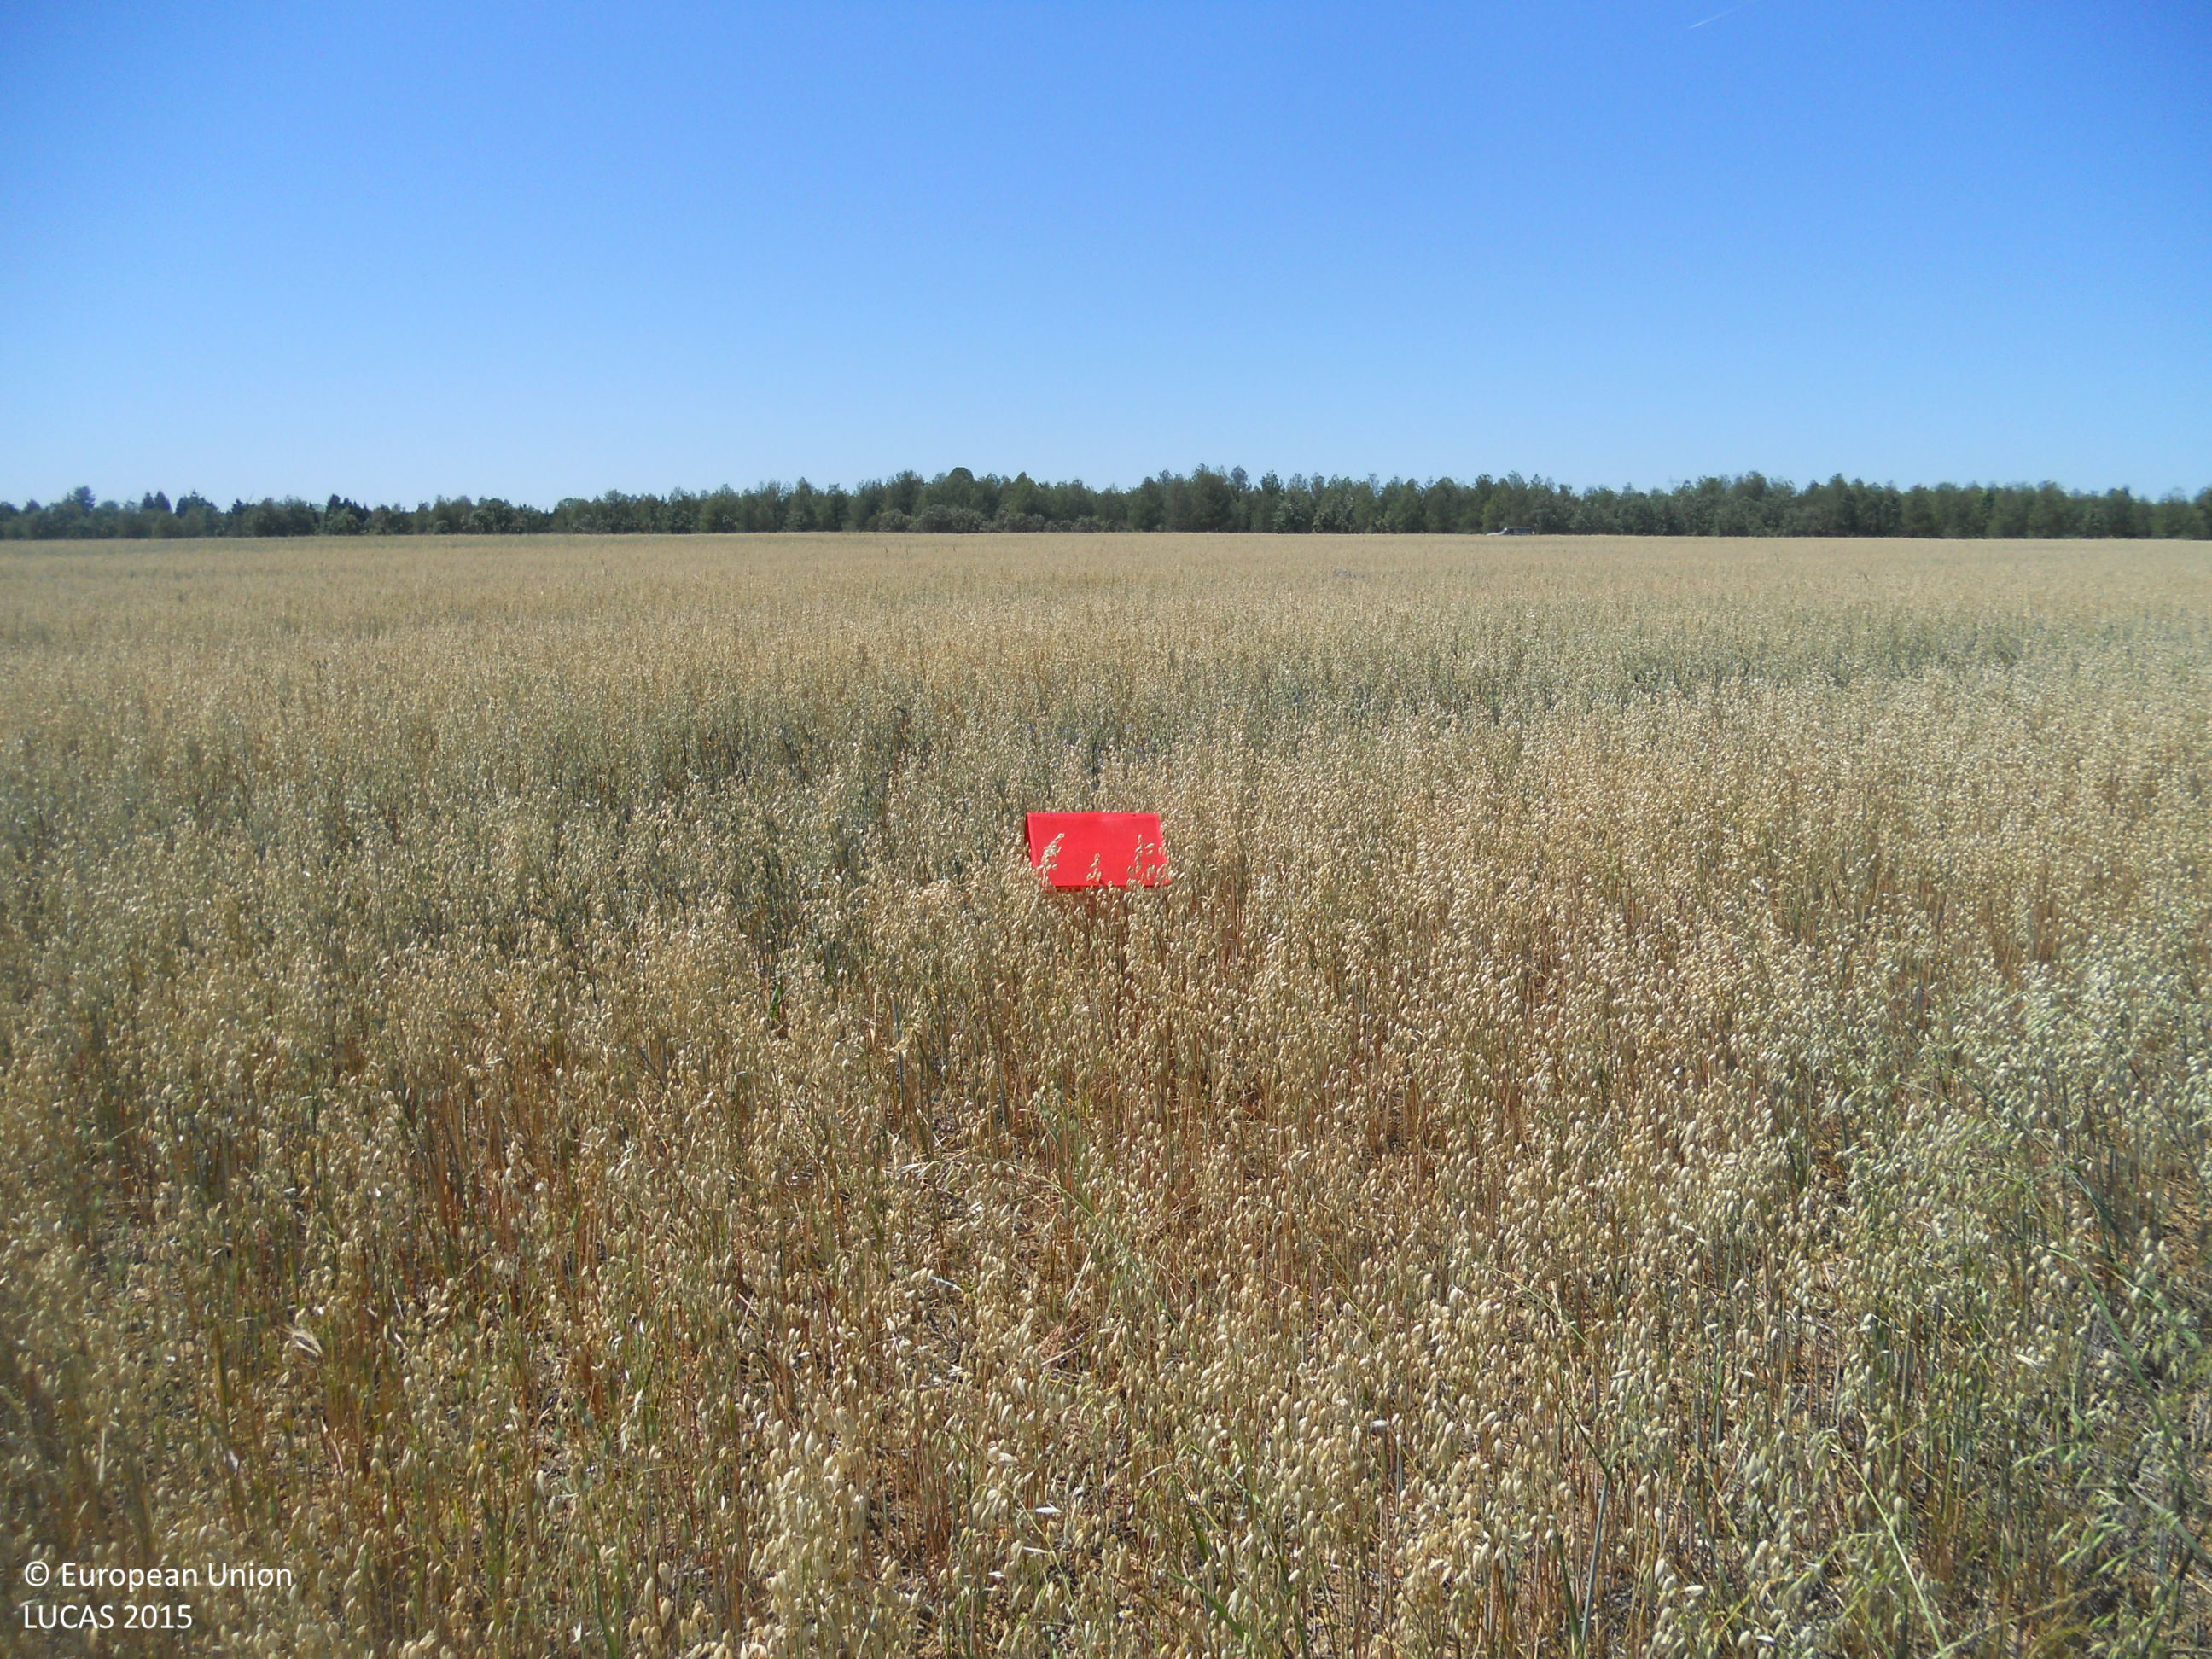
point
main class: Cropland
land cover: Oats
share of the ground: > 75 %
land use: Agriculture (excluding fallow land and kitchen gardens)
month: June
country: ES
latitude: 42.4323
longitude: -4.8497
